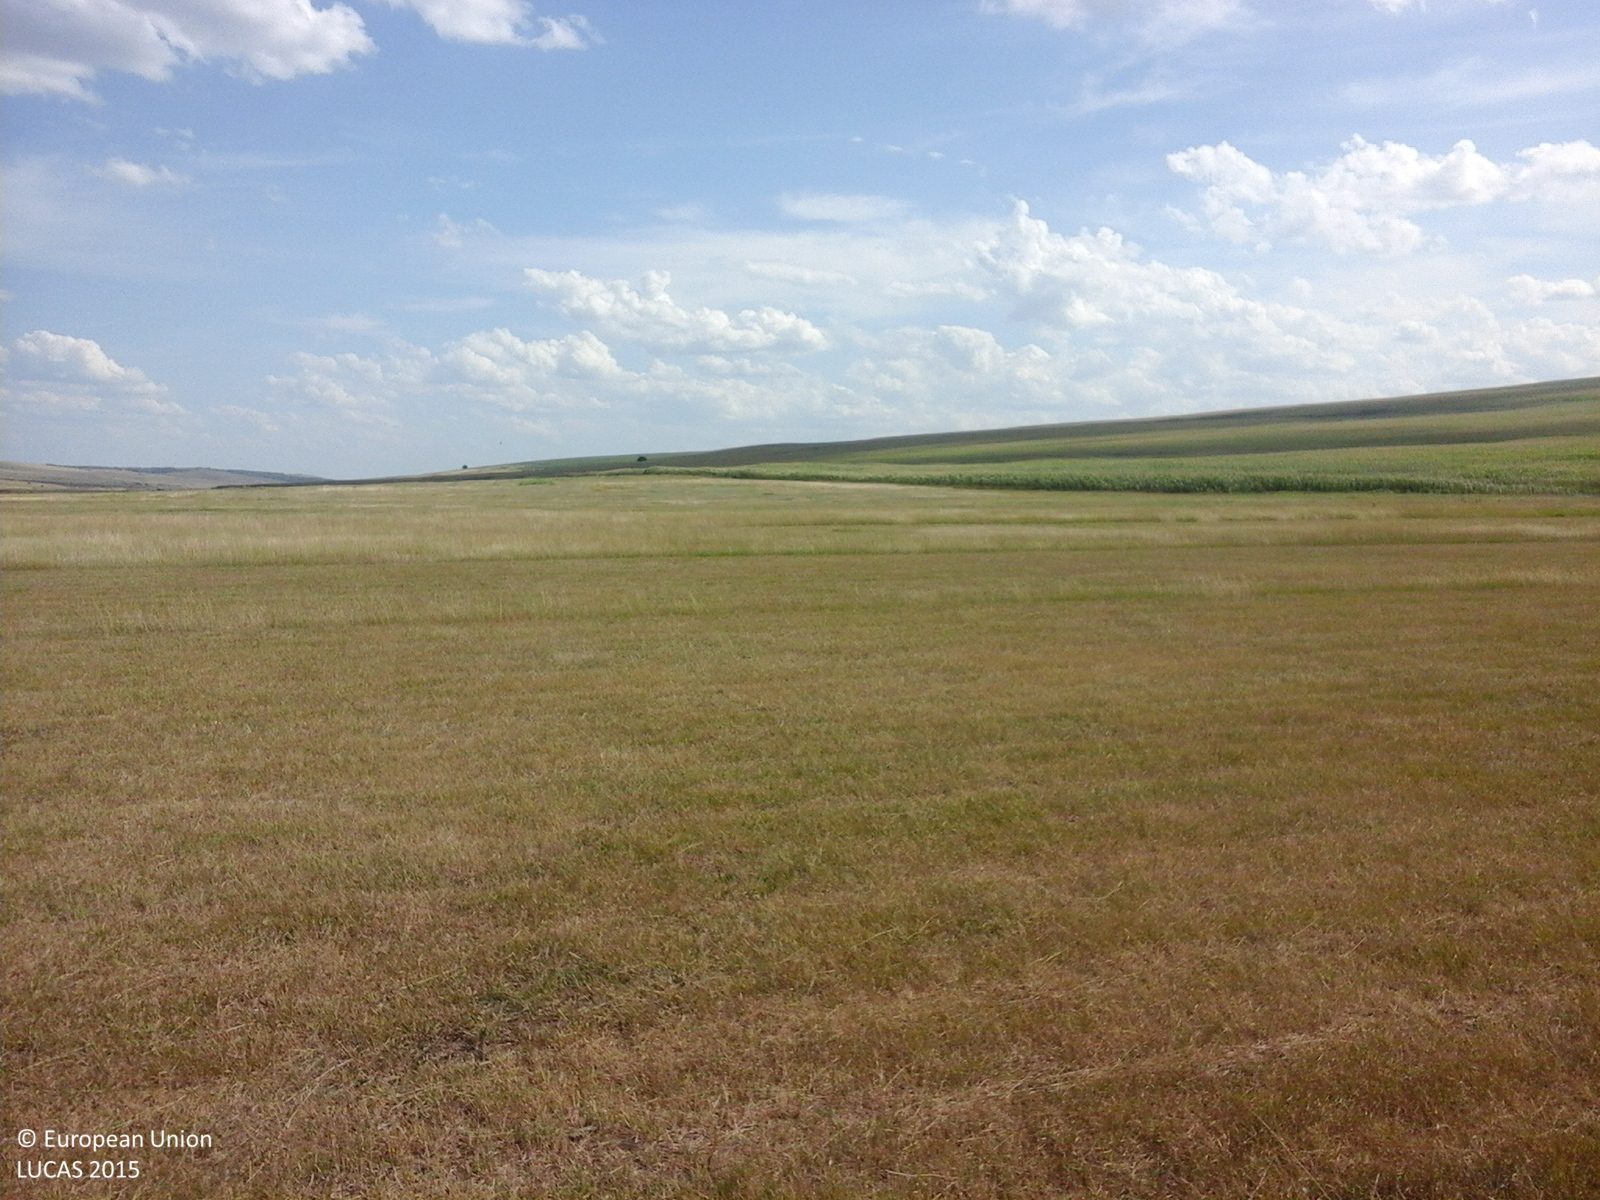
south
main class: Grassland
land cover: Grassland without tree/shrub cover
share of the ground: > 75 %
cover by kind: herbaceous plants 100 %
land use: Agriculture (excluding fallow land and kitchen gardens)
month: July
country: RO
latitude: 46.5009
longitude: 28.1256
